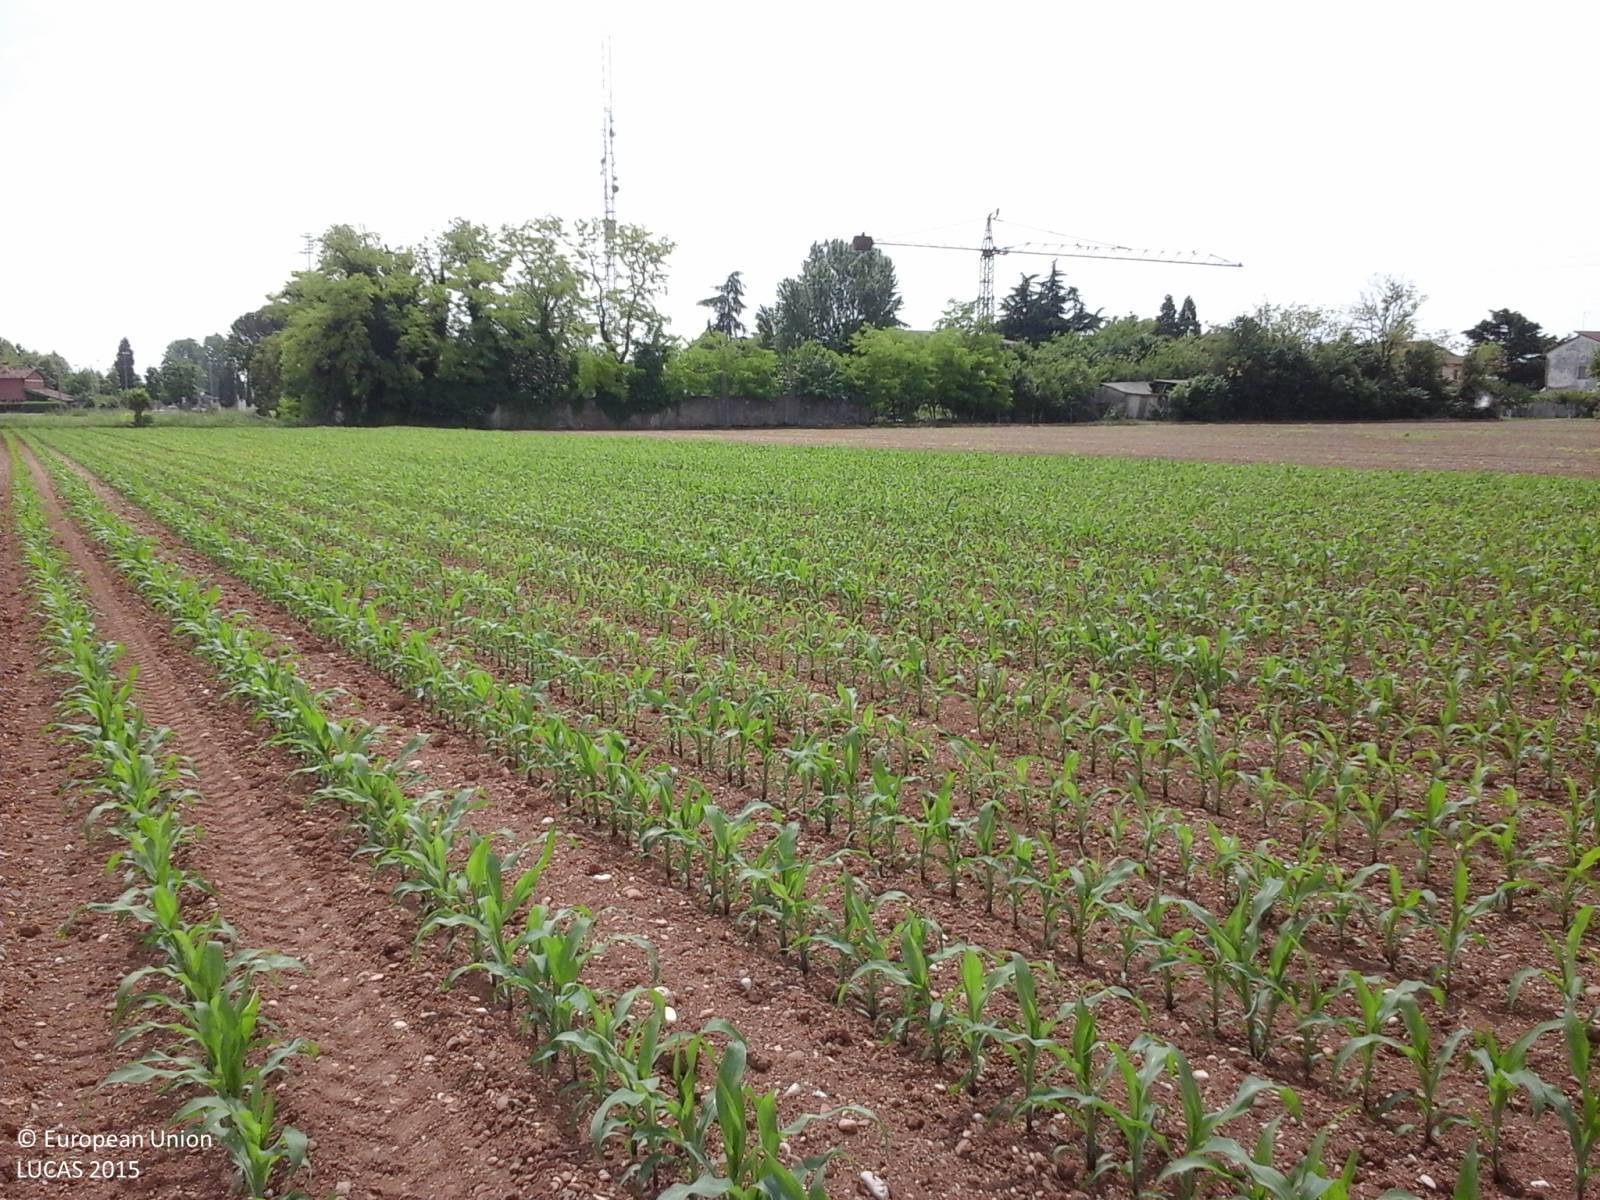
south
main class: Cropland
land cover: Maize
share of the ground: 25 - 50 %
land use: Agriculture (excluding fallow land and kitchen gardens)
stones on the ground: 10 - 25 %
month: May
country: IT
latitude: 45.9066
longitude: 13.2060
